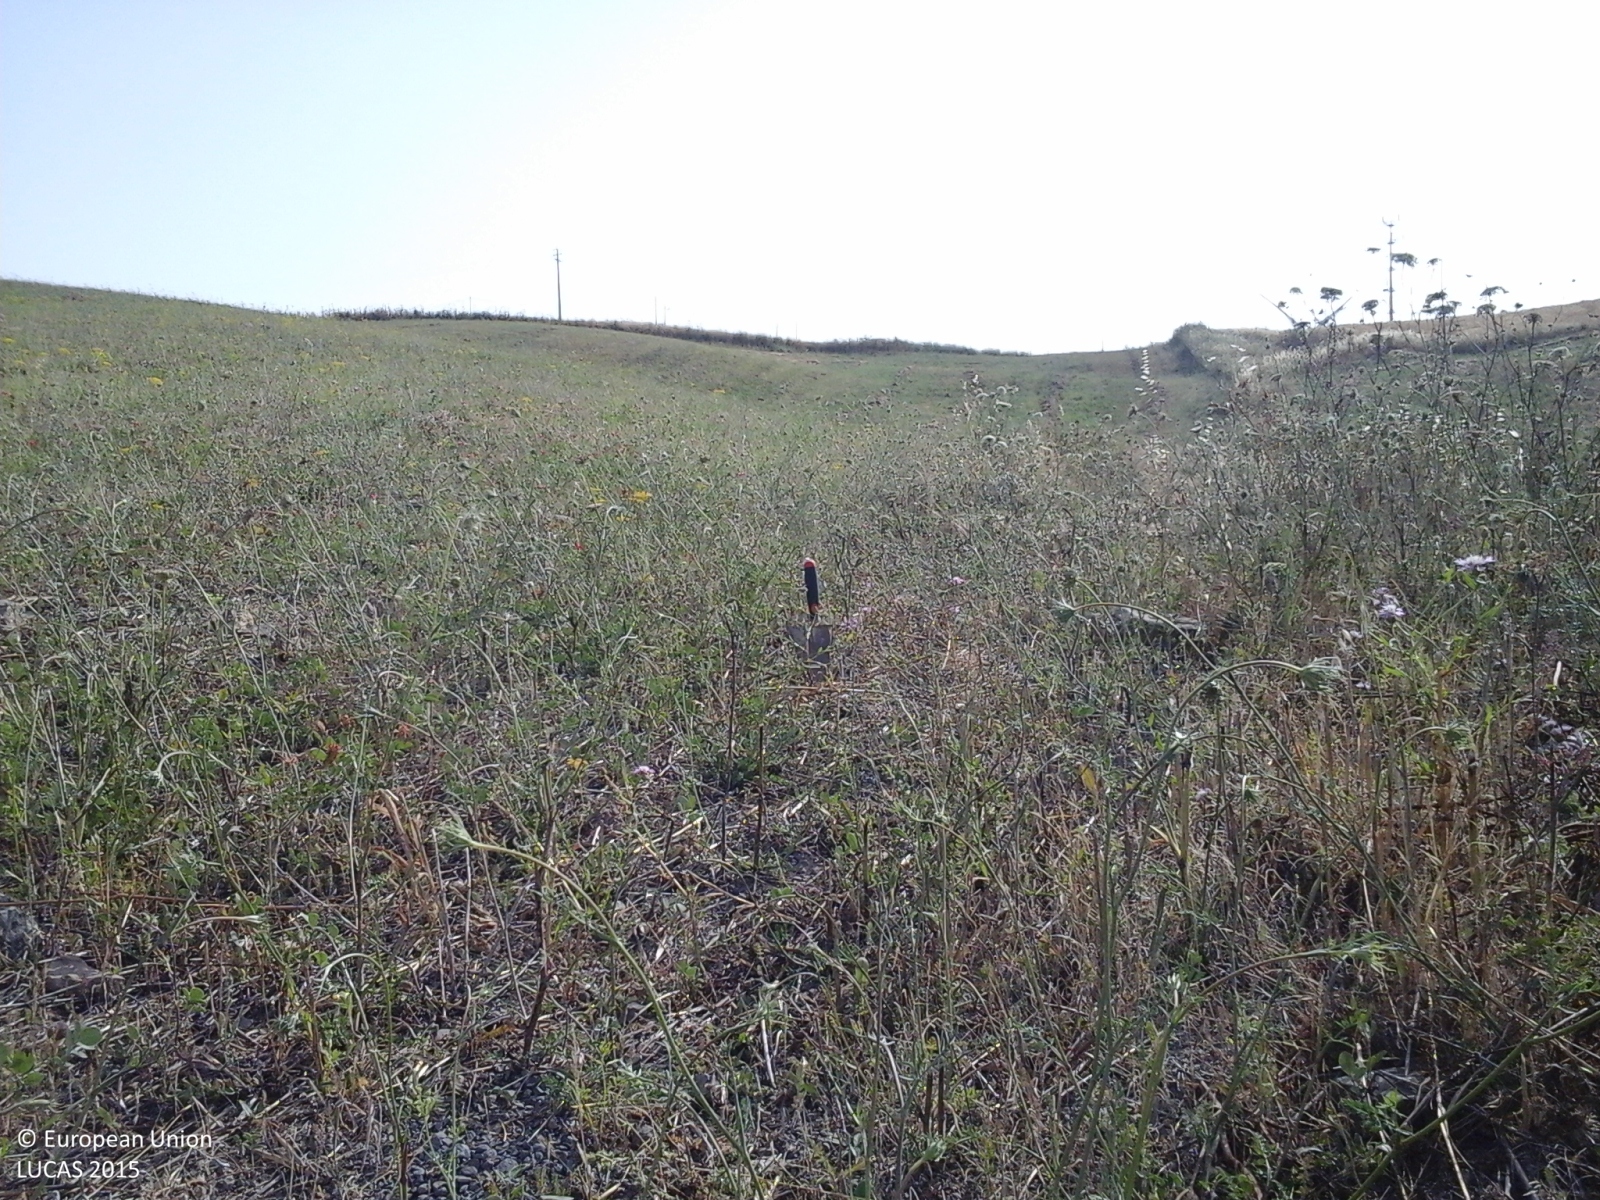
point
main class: Cropland
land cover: Temporary grasslands
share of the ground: > 75 %
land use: Agriculture (excluding fallow land and kitchen gardens)
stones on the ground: < 10 %
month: June
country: IT
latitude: 37.7704
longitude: 13.5953
